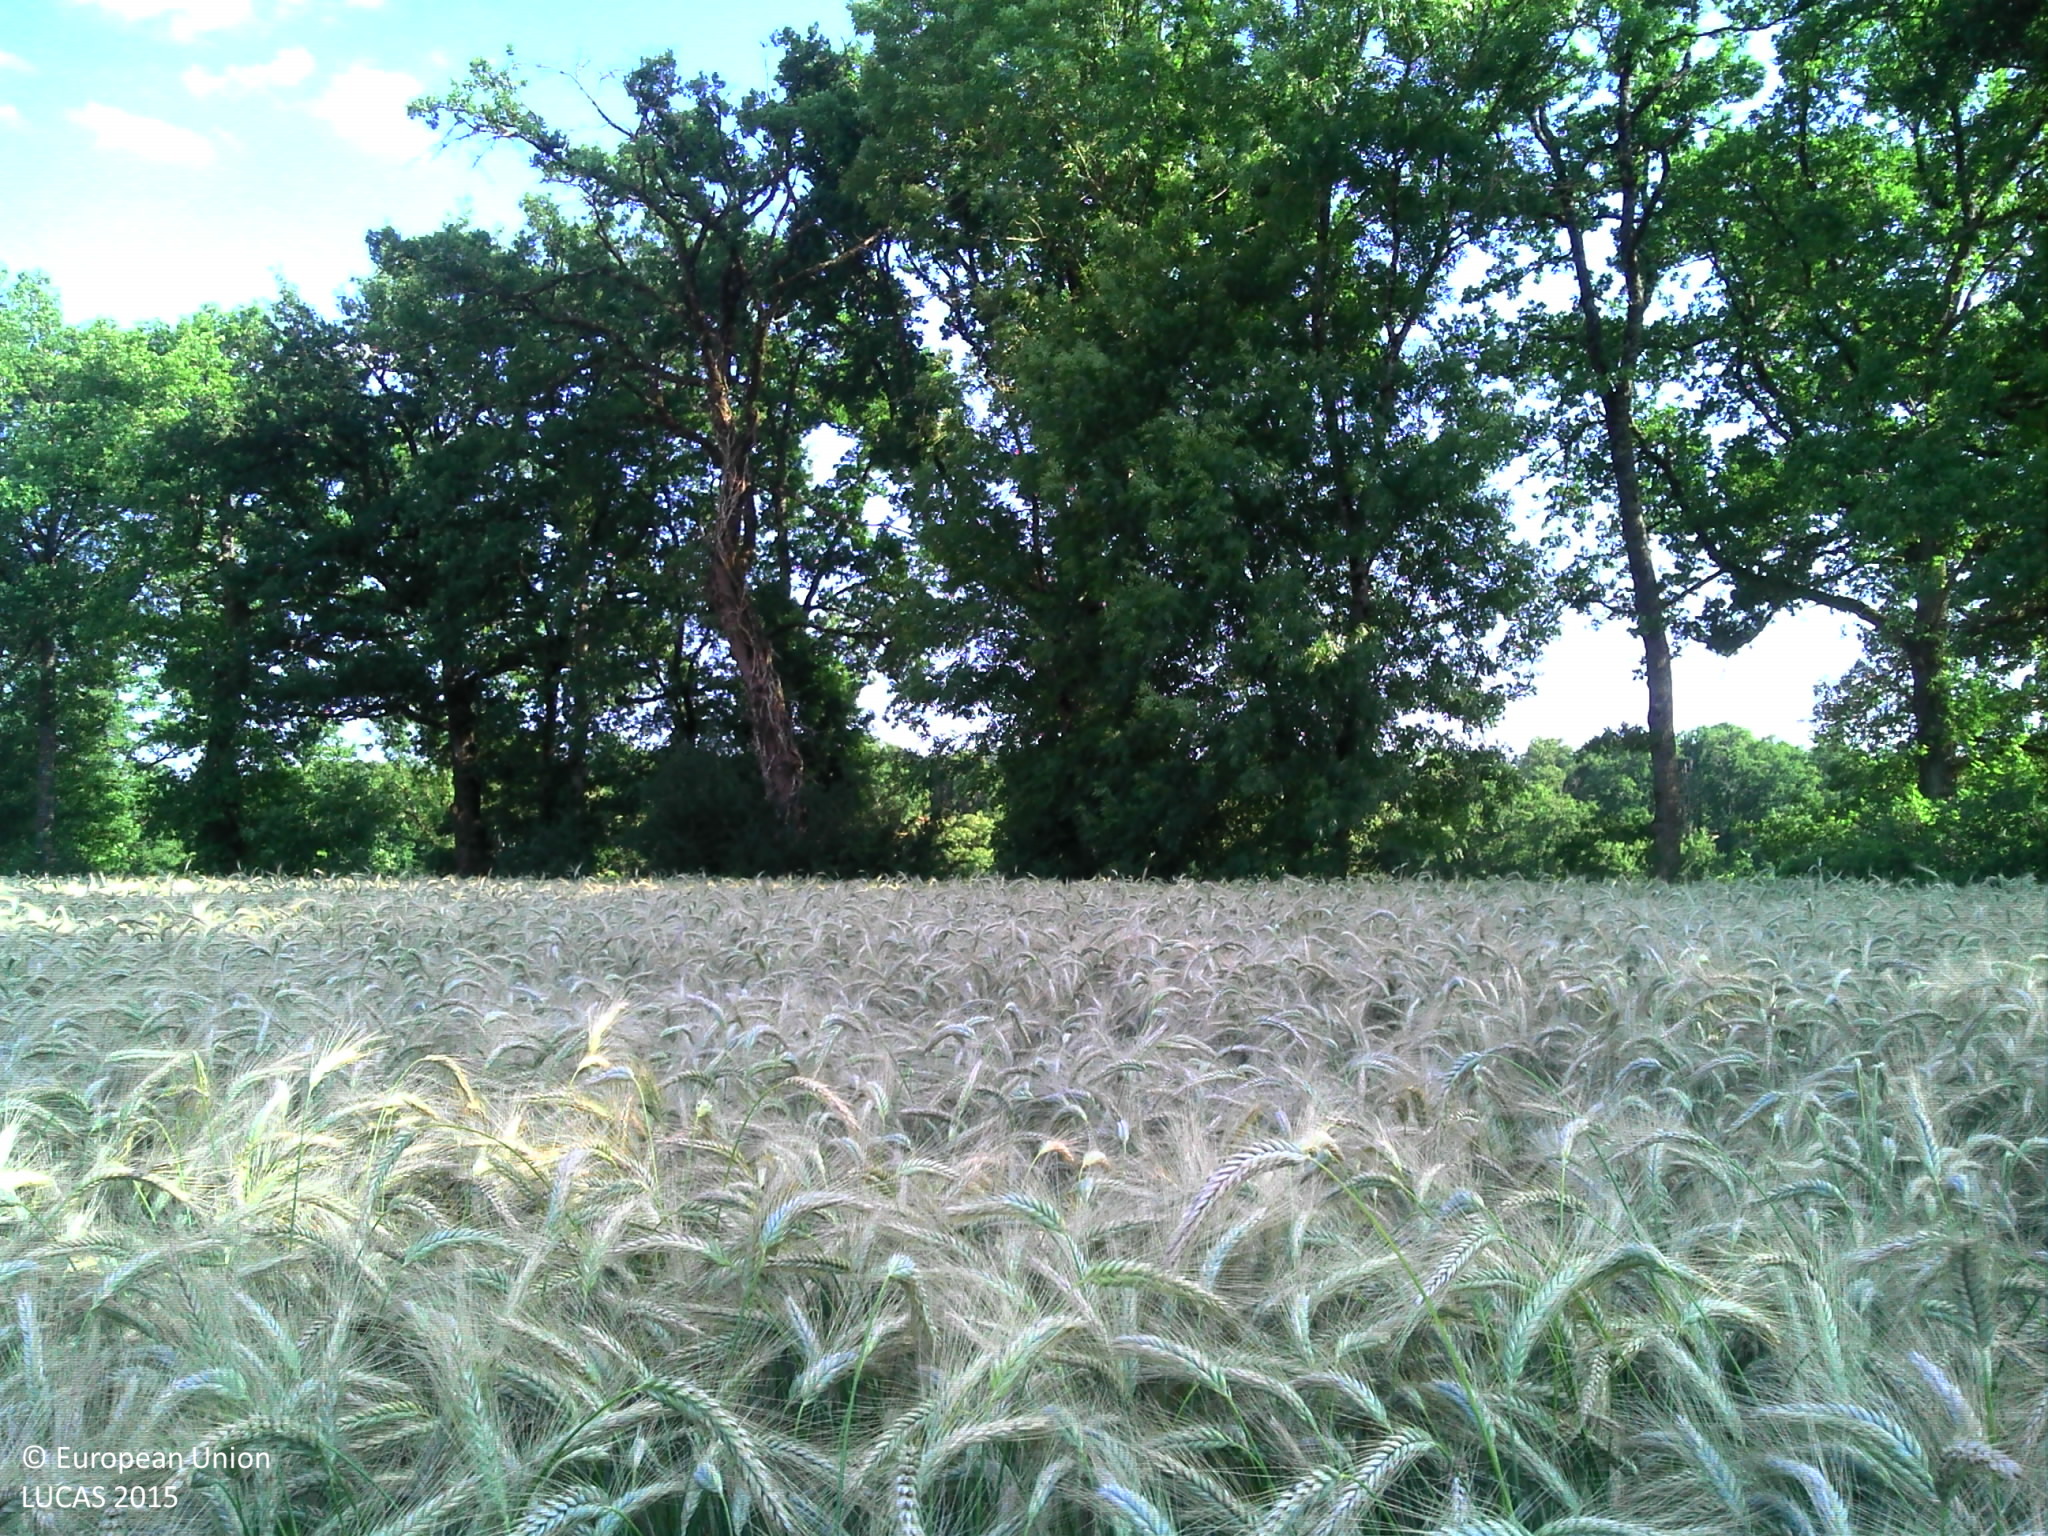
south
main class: Cropland
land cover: Triticale
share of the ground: > 75 %
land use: Agriculture (excluding fallow land and kitchen gardens)
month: June
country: FR
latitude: 45.9418
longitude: 0.6603
